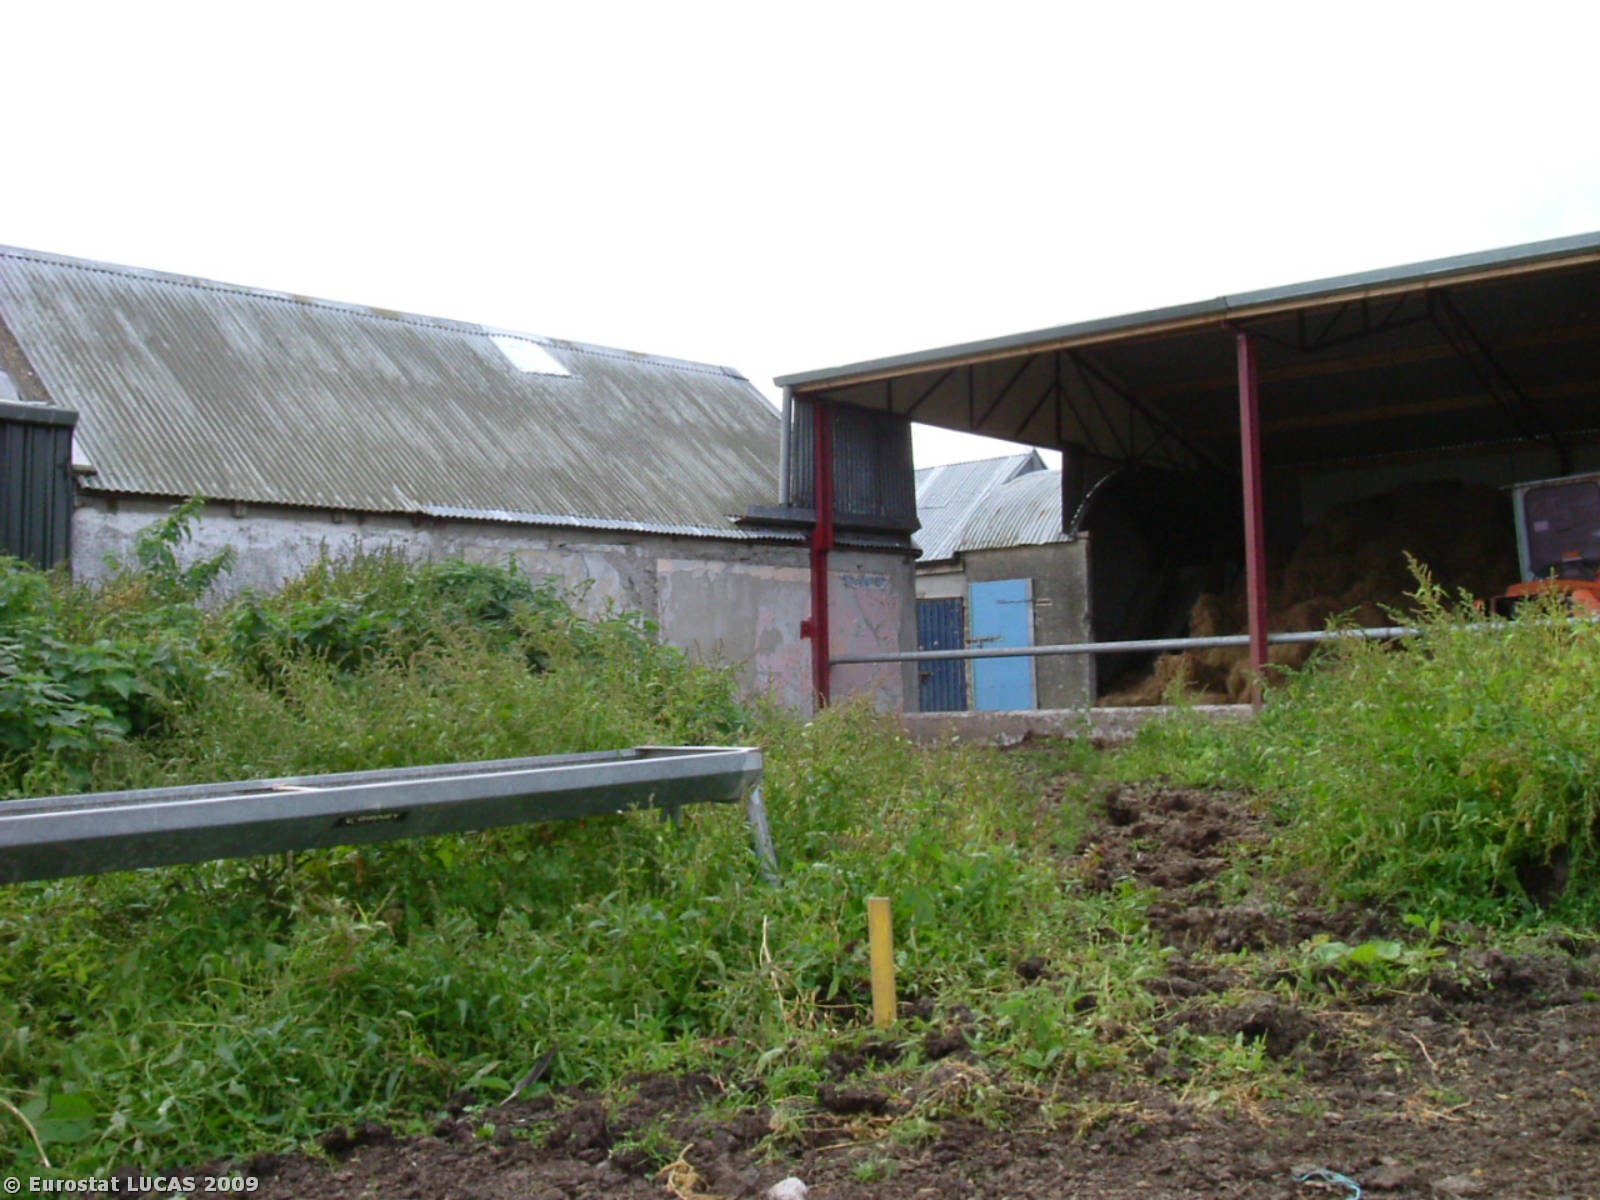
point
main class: Grassland
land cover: Spontaneously vegetated surfaces
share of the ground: > 75 %
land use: Fallow land
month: October
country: IE
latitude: 52.7258
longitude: -7.7121
